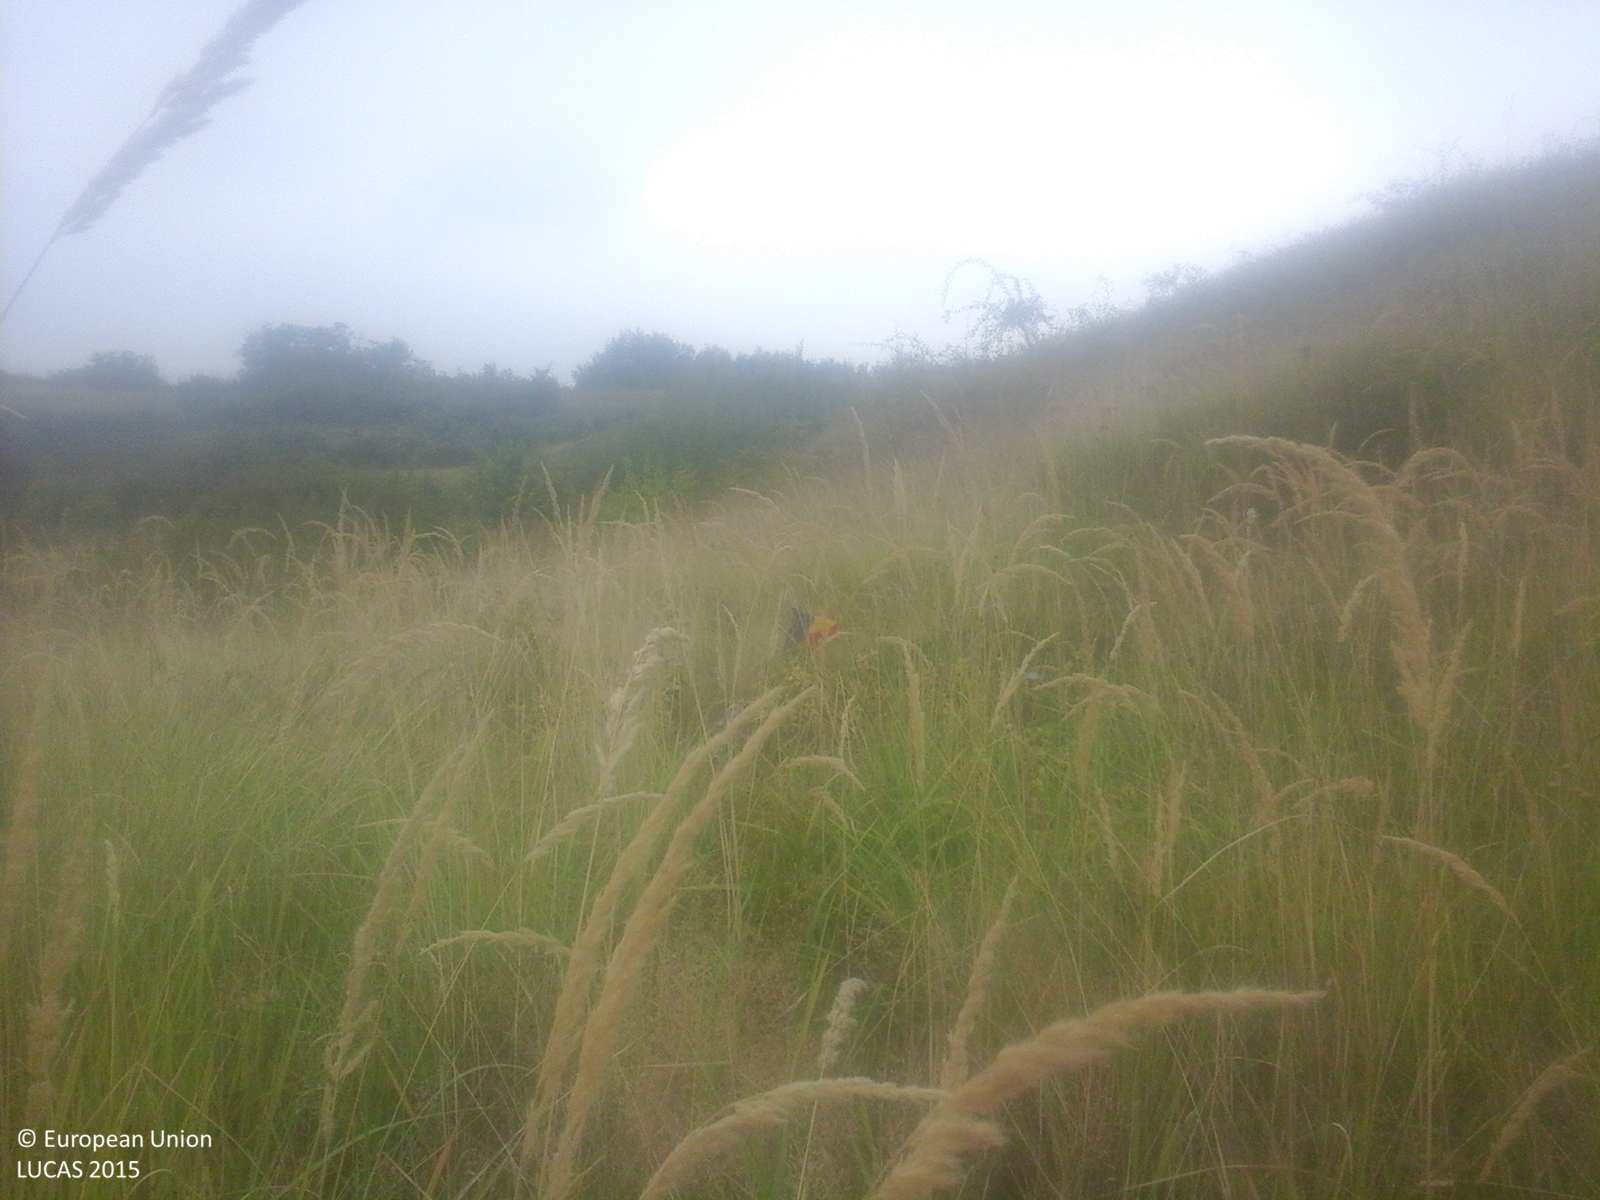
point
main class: Grassland
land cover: Spontaneously vegetated surfaces
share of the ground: > 75 %
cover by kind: herbaceous plants 100 %
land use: Fallow land
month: September
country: RO
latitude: 44.7446
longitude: 23.1981
